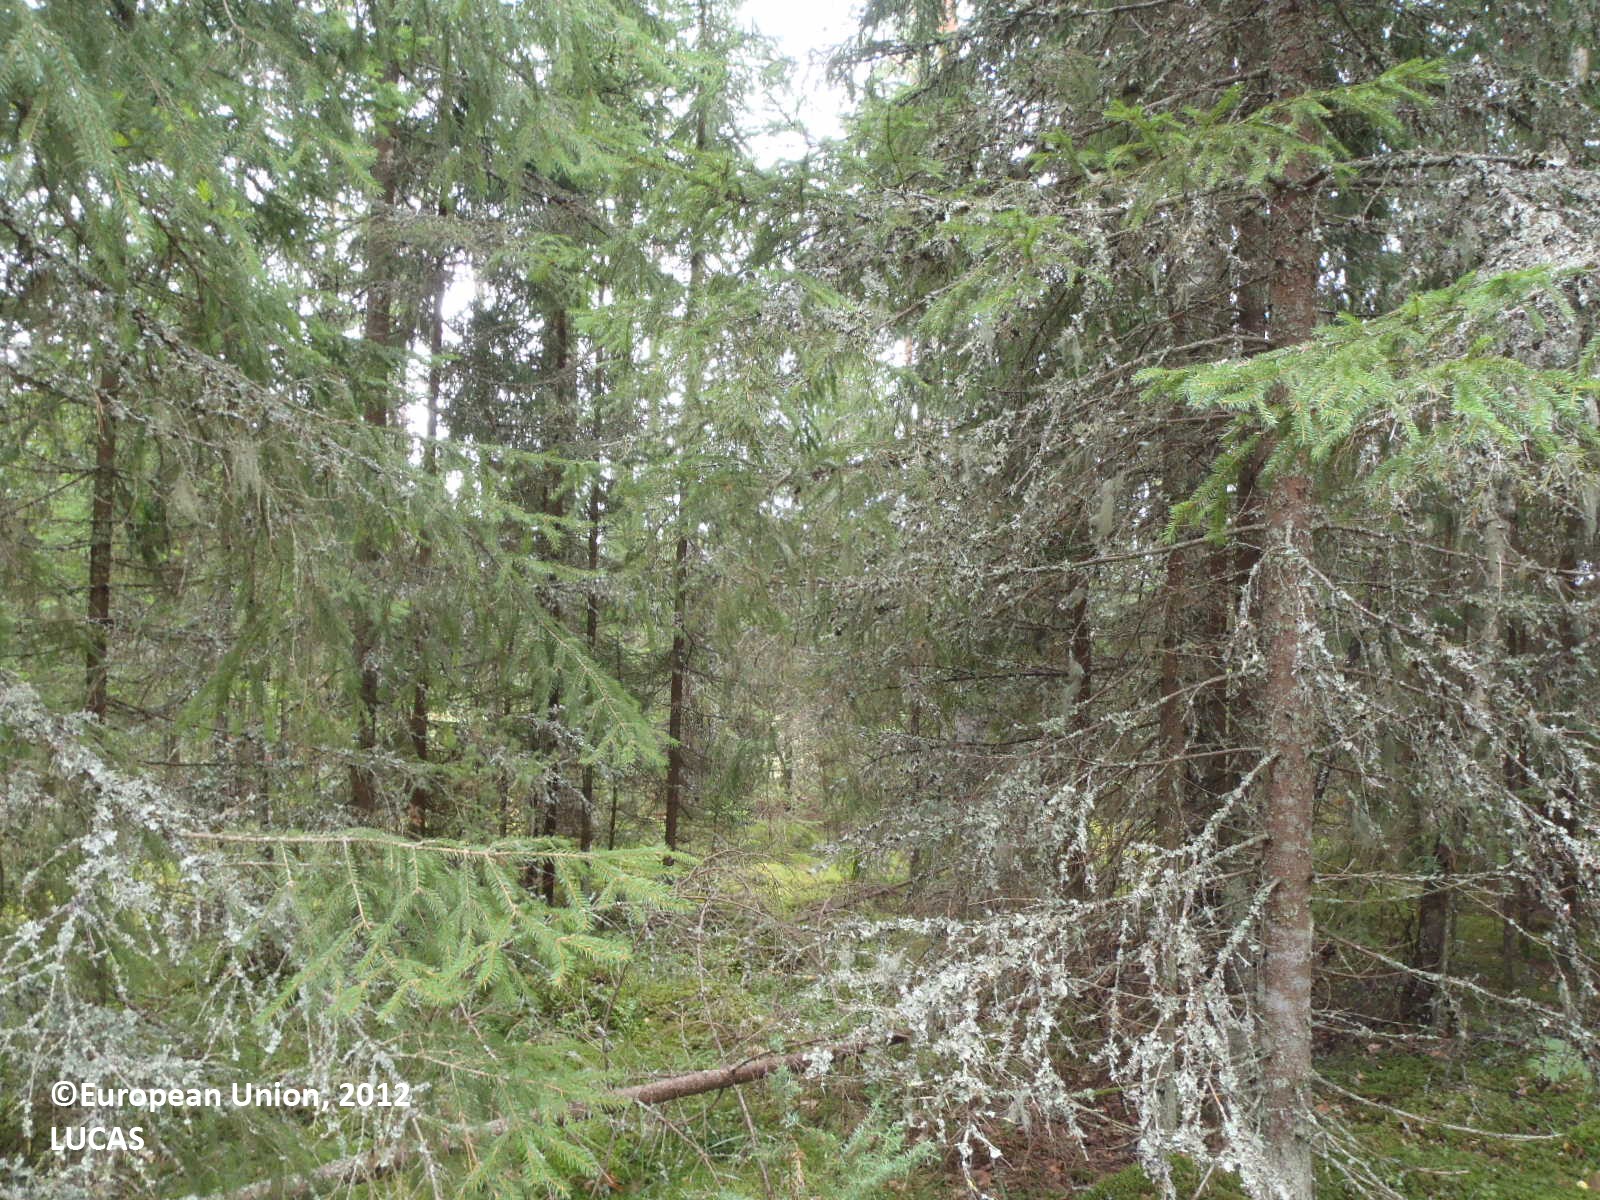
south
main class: Woodland
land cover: Pine dominated coniferous woodland
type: boreal forest
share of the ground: > 75 %
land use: Forestry
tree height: > 5 m
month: August
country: FI
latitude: 60.9051
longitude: 21.8017
